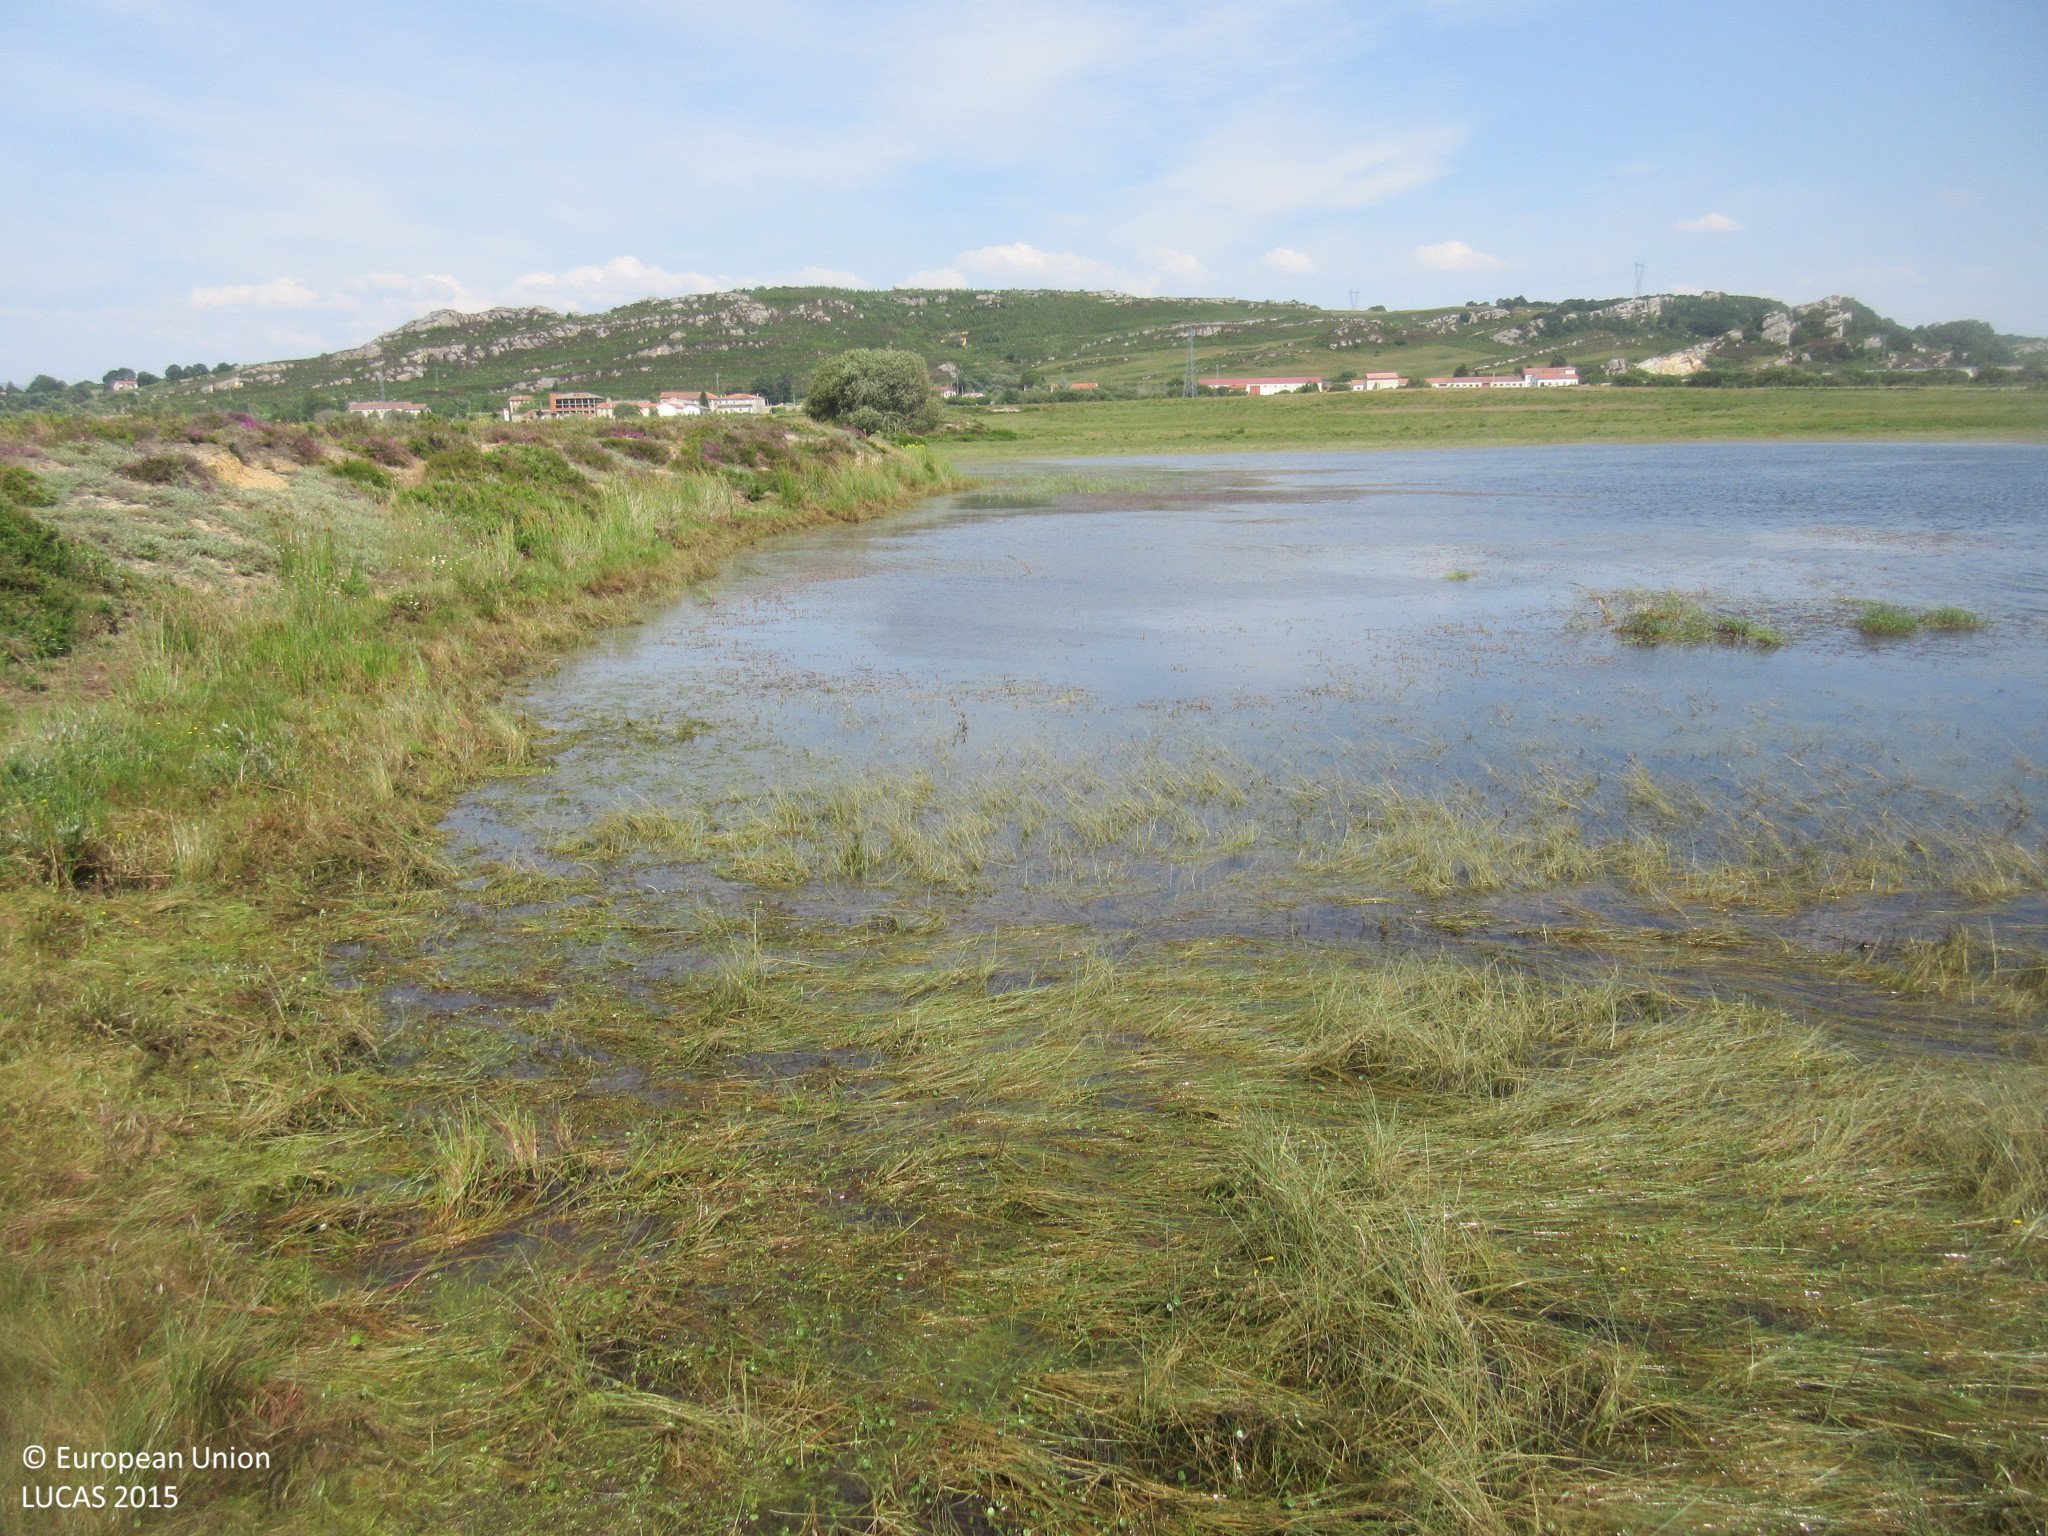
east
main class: Grassland
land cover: Grassland without tree/shrub cover
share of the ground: > 75 %
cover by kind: herbaceous plants 100 %
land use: Agriculture (excluding fallow land and kitchen gardens)
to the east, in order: Grassland without tree/shrub cover; Inland marshes; Grassland without tree/shrub cover
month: July
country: ES
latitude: 42.9935
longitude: -3.8688
